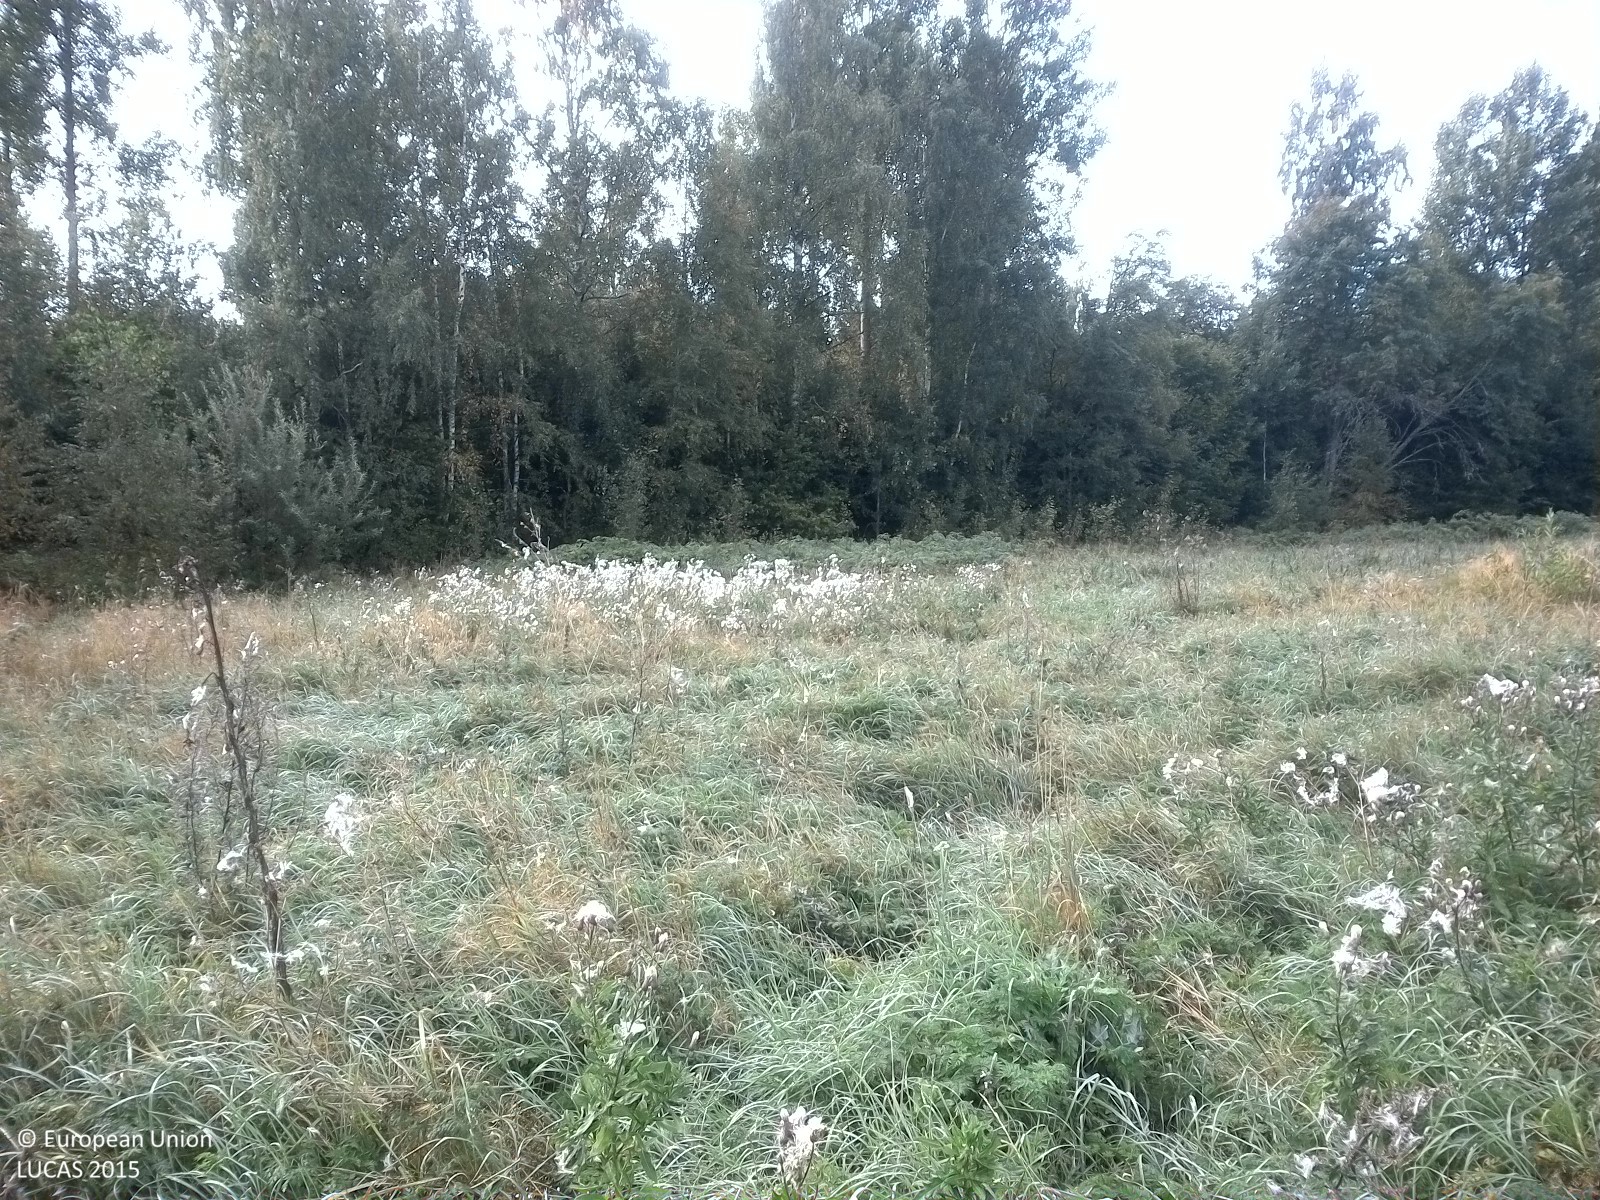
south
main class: Grassland
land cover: Spontaneously vegetated surfaces
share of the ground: > 75 %
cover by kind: herbaceous plants 100 %
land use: Semi-natural and natural areas not in use
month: August
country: SE
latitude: 59.3088
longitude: 15.6654
